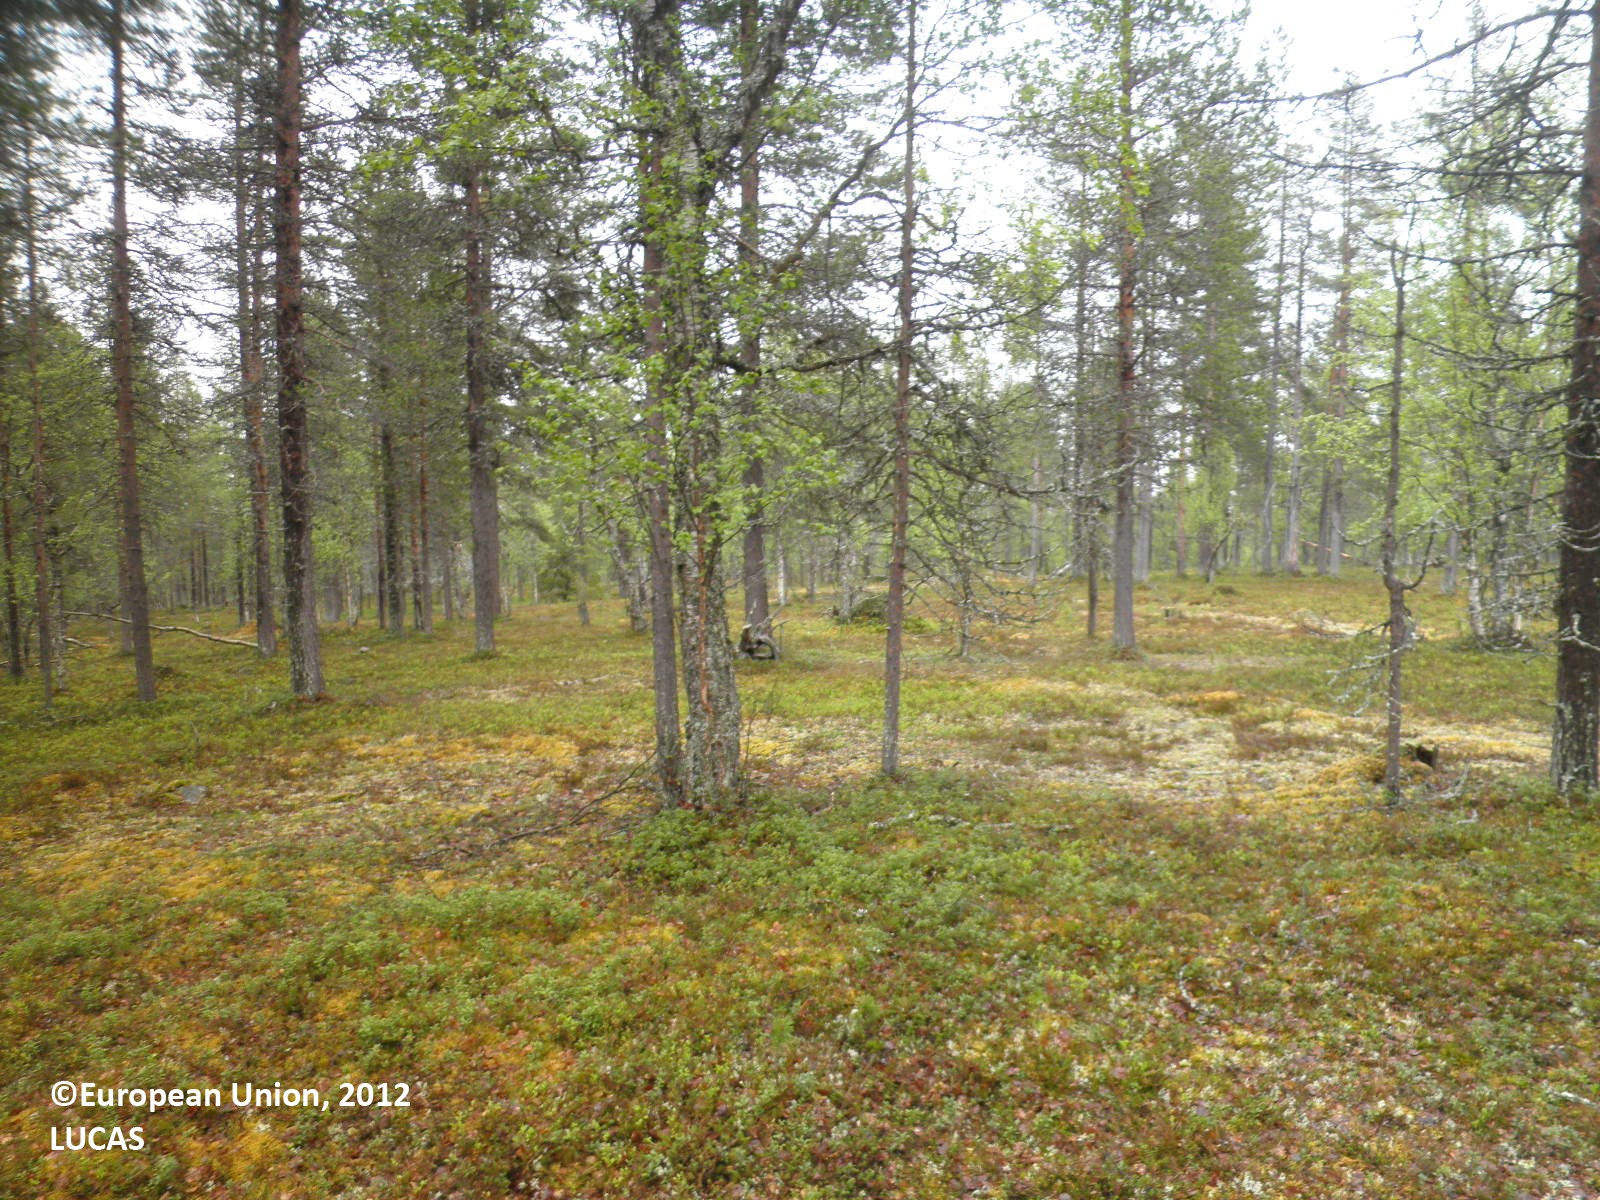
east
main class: Woodland
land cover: Pine dominated coniferous woodland
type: boreal forest
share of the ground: 25 - 50 %
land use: Forestry
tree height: > 5 m
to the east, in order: Pine dominated coniferous woodland; Pine dominated mixed woodland; Pine dominated coniferous woodland; Pine dominated mixed woodland
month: June
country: FI
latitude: 68.1420
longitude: 25.6135
